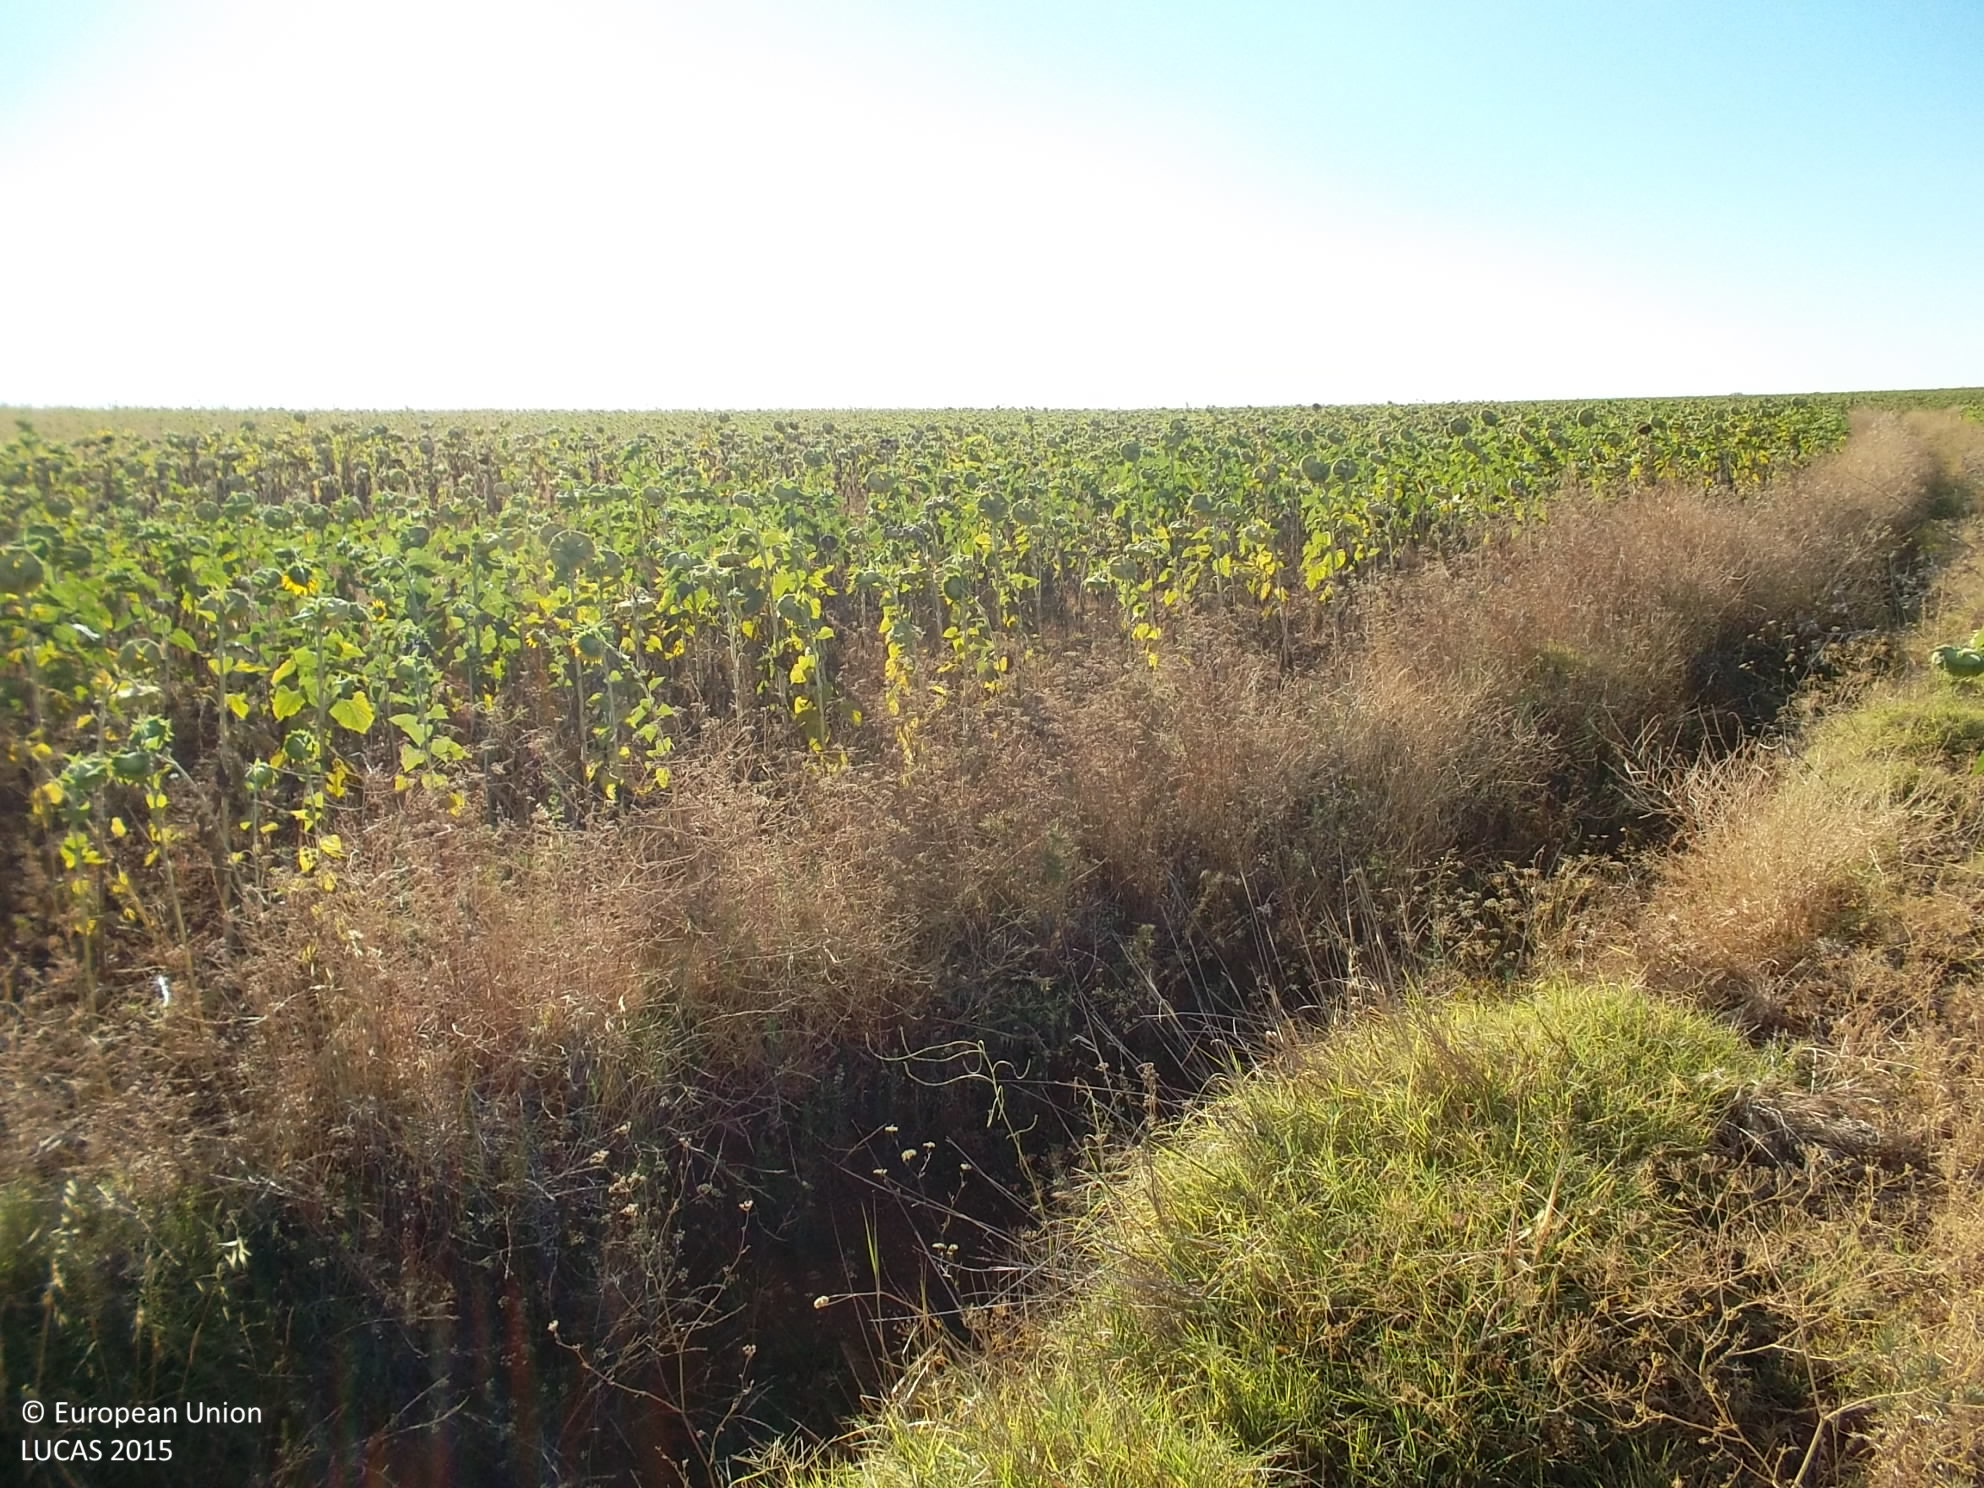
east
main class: Cropland
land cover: Sunflower
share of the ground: > 75 %
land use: Agriculture (excluding fallow land and kitchen gardens)
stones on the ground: < 10 %
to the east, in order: Sunflower; Grass margins; Rock outcrops; Grass margins; Sunflower
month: July
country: ES
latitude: 38.3605
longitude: -5.7502
